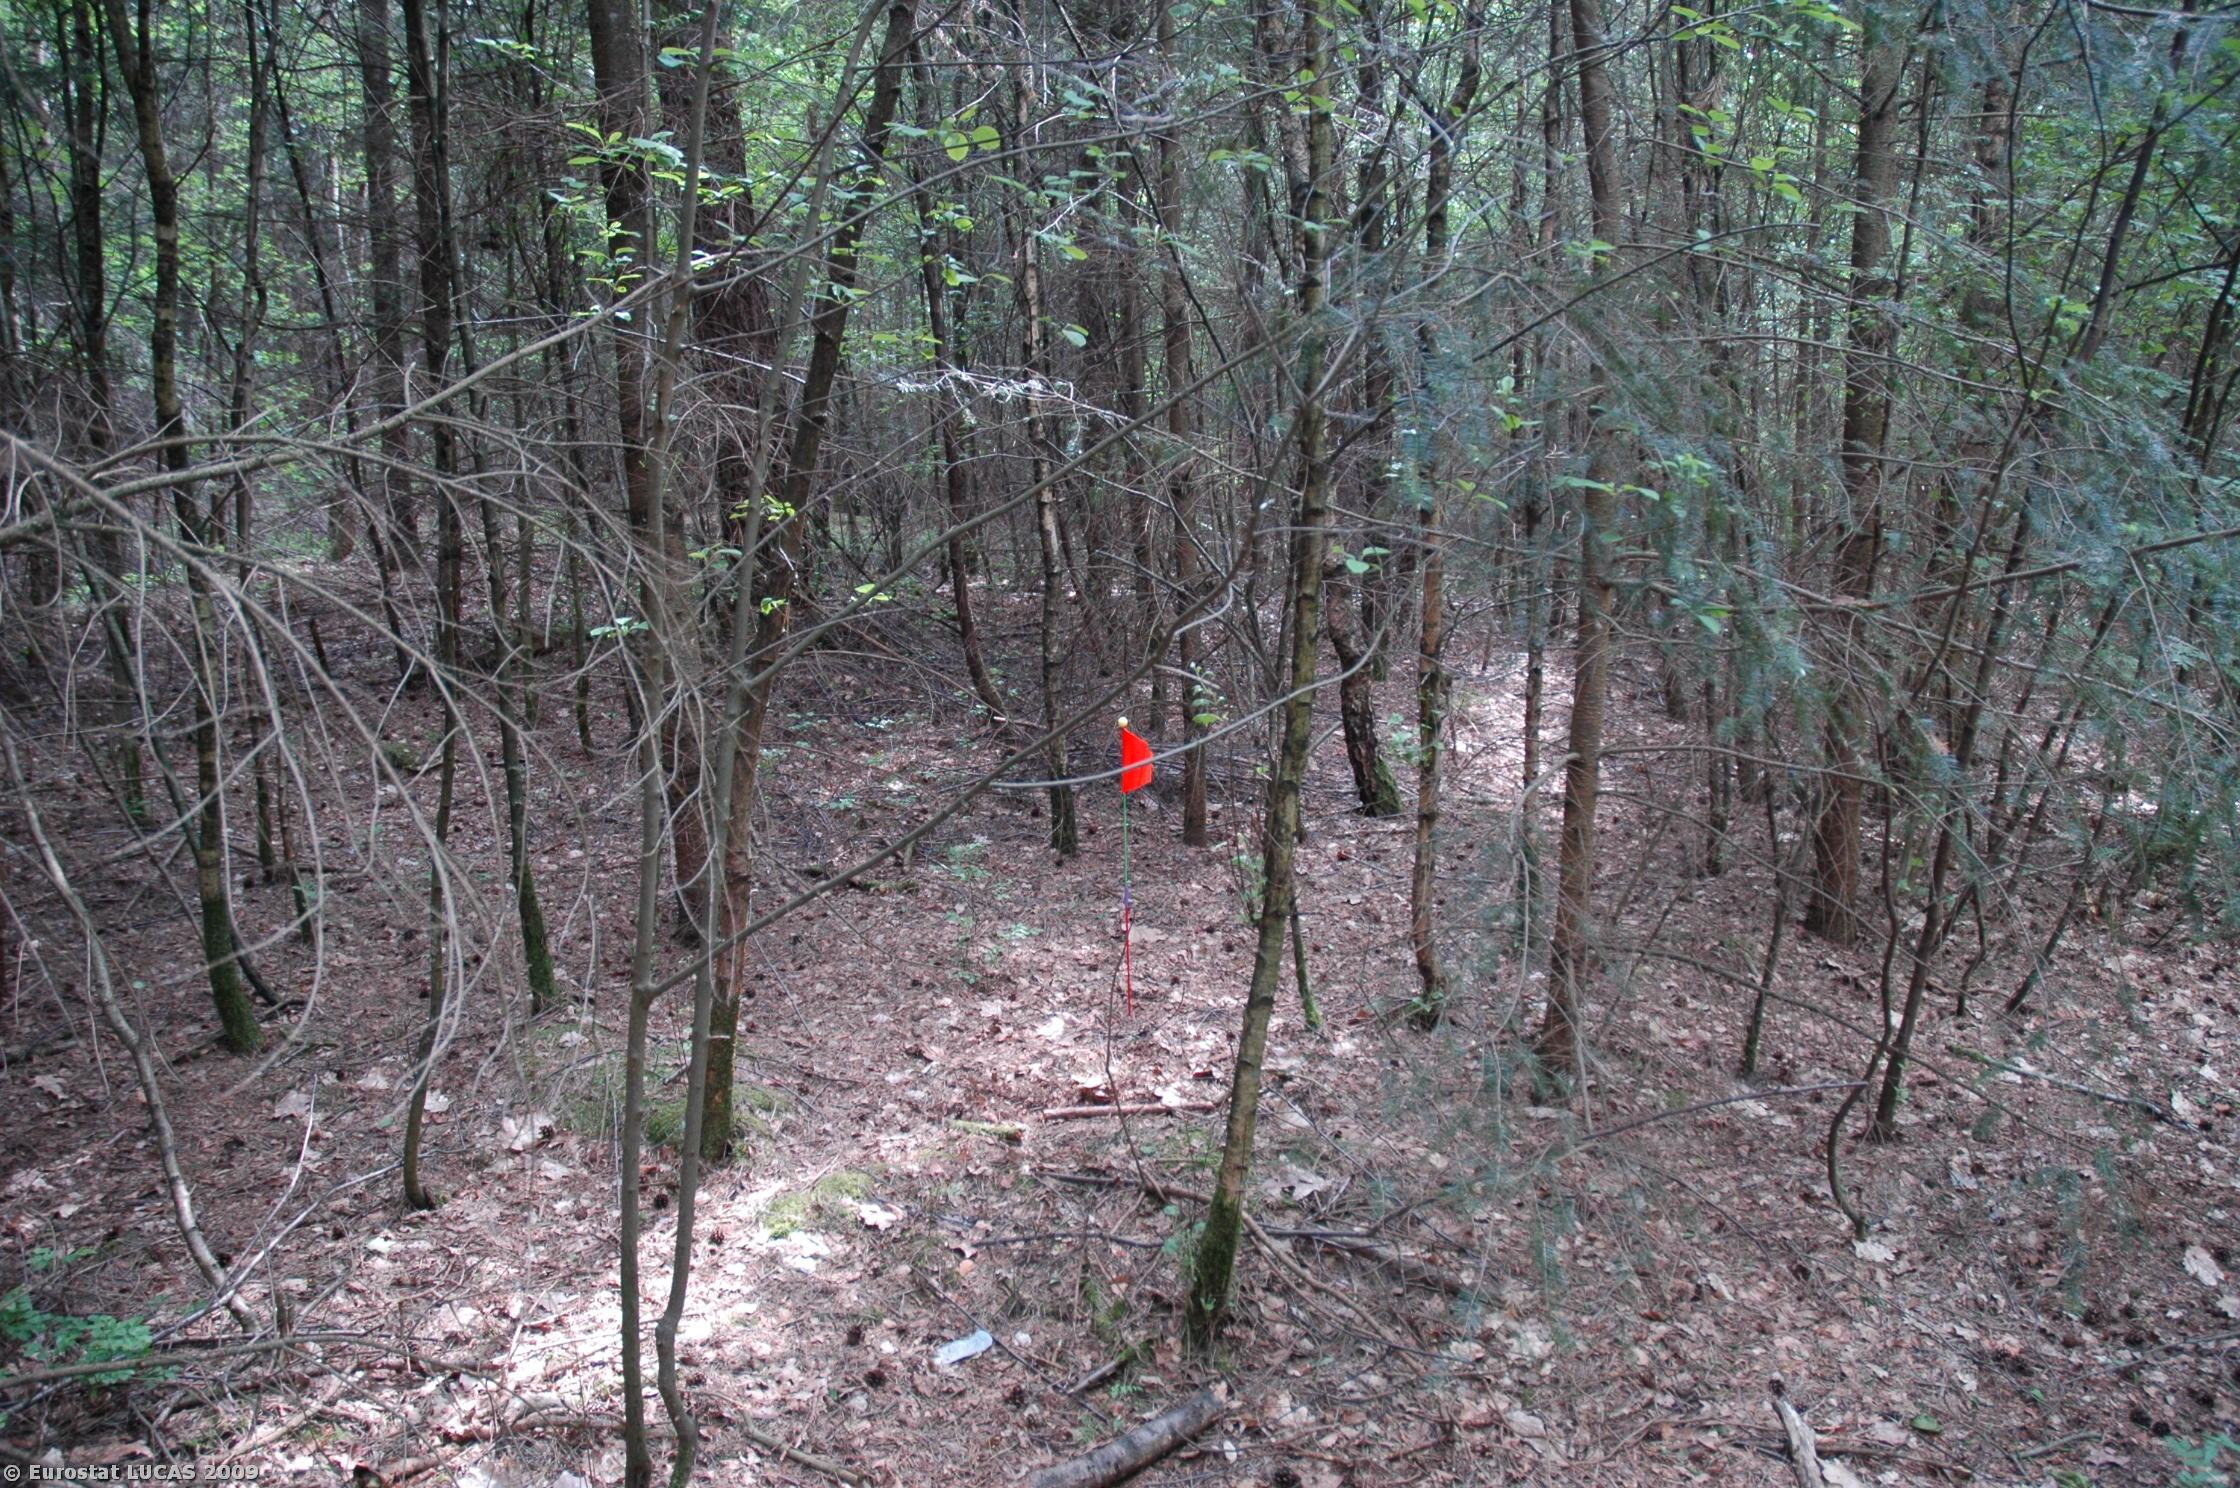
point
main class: Woodland
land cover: Mixed woodland
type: hemiboreal forest and nemoral coniferous forest and mixed broadleaved-coniferous forest
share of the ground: > 75 %
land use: Amenities, museums, leisure
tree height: > 5 m
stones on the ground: < 10 %
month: May
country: NL
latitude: 52.0881
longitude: 5.3423
